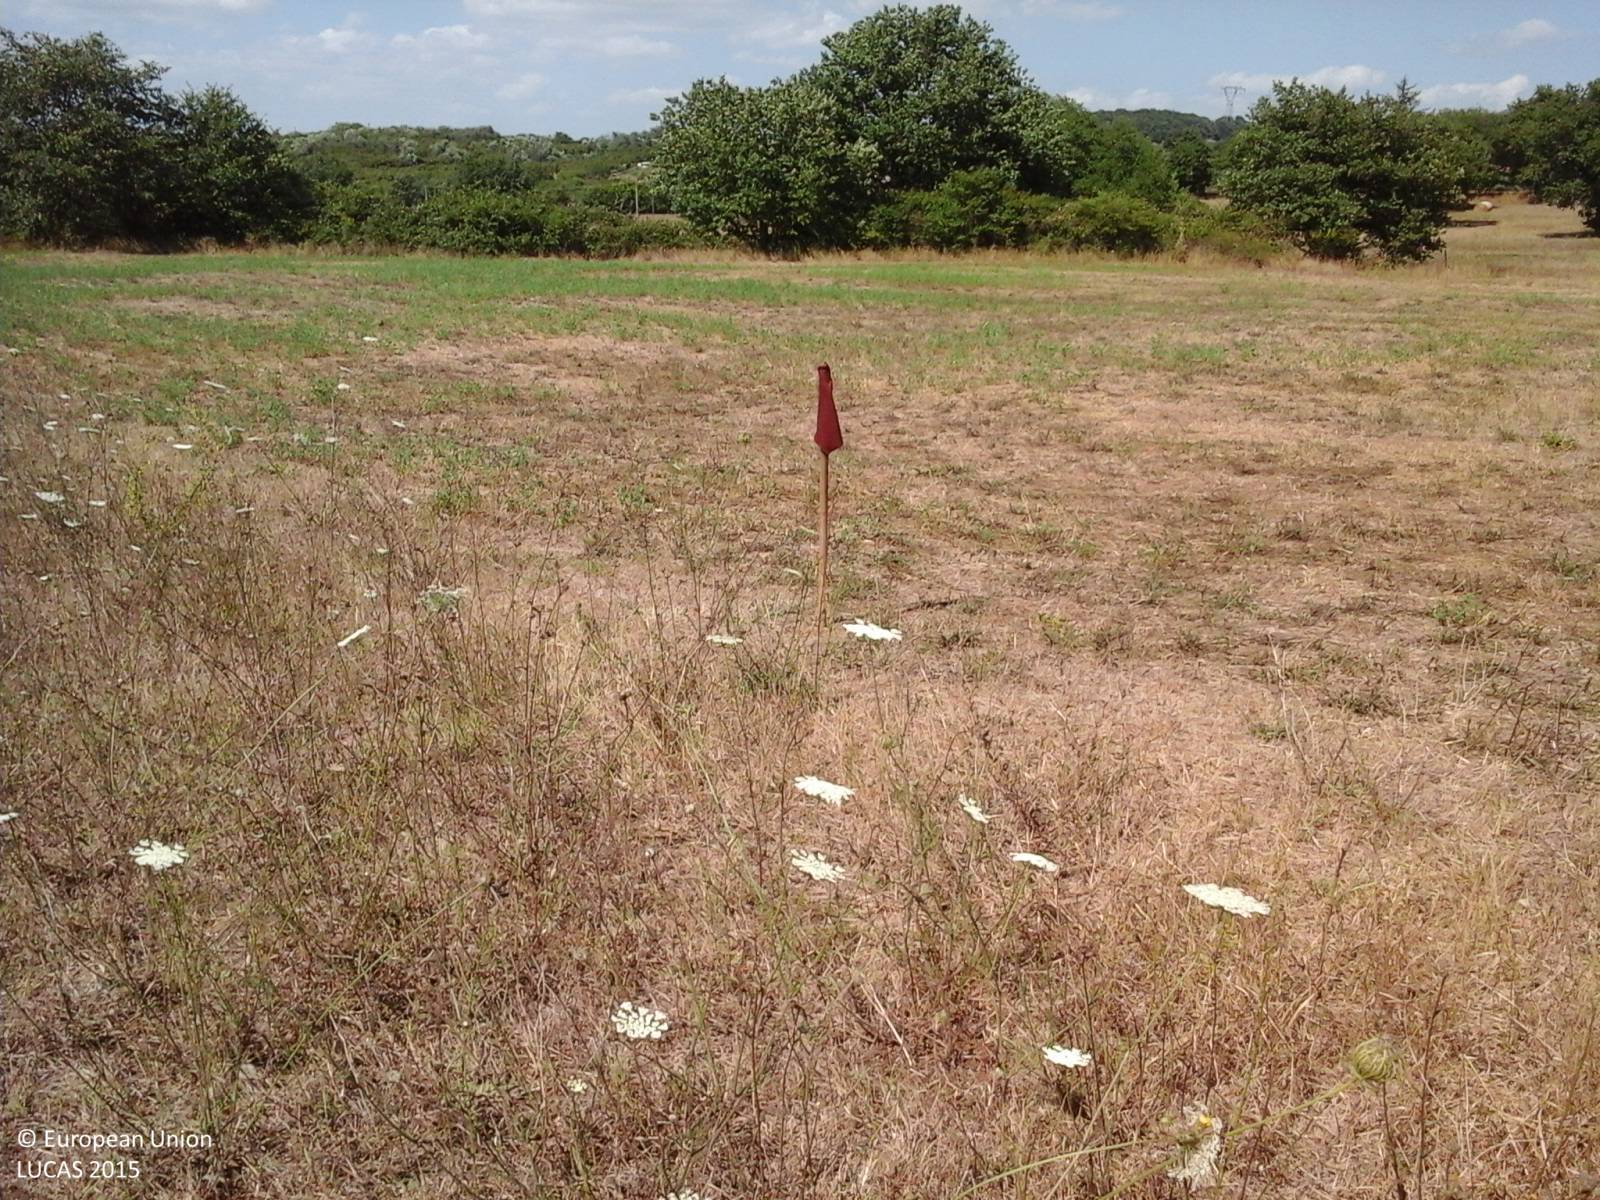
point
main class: Cropland
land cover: Lucerne
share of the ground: > 75 %
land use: Agriculture (excluding fallow land and kitchen gardens)
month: July
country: IT
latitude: 42.2088
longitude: 12.4502
